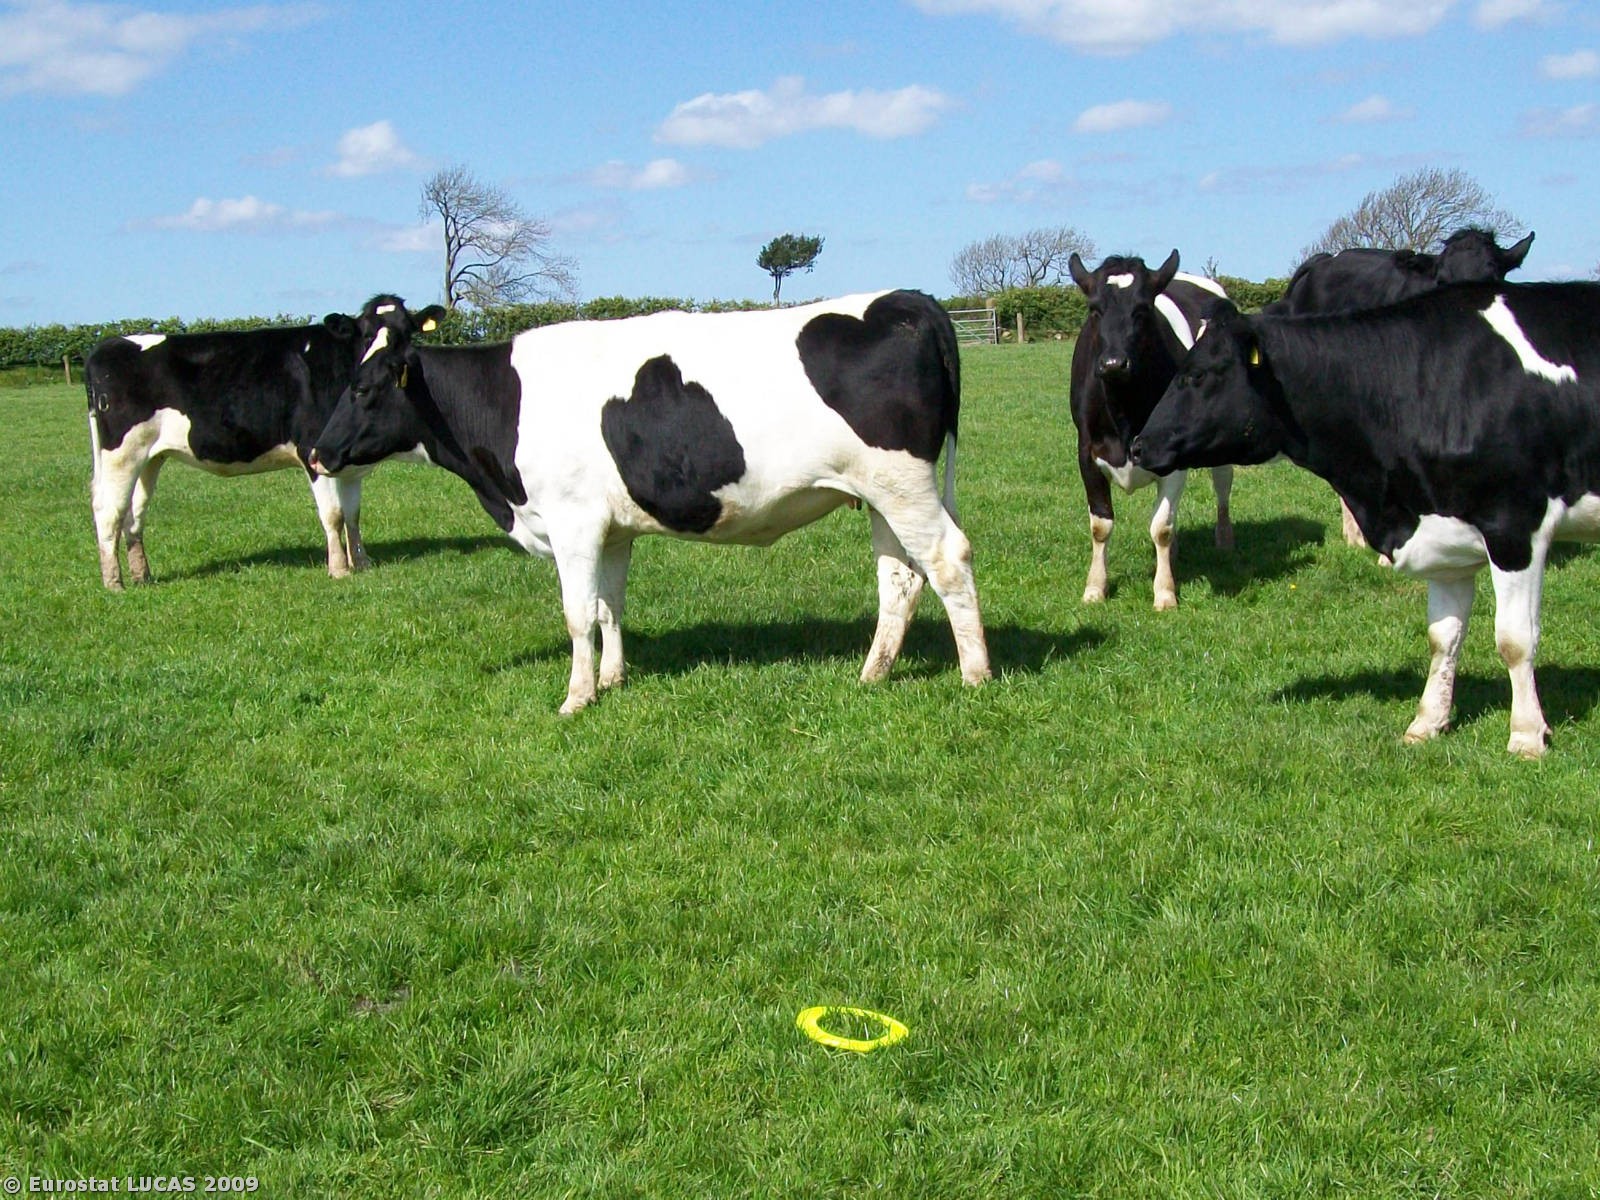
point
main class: Grassland
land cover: Grassland without tree/shrub cover
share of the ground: > 75 %
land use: Agriculture (excluding fallow land and kitchen gardens)
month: May
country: GB
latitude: 54.8063
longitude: -3.2224
